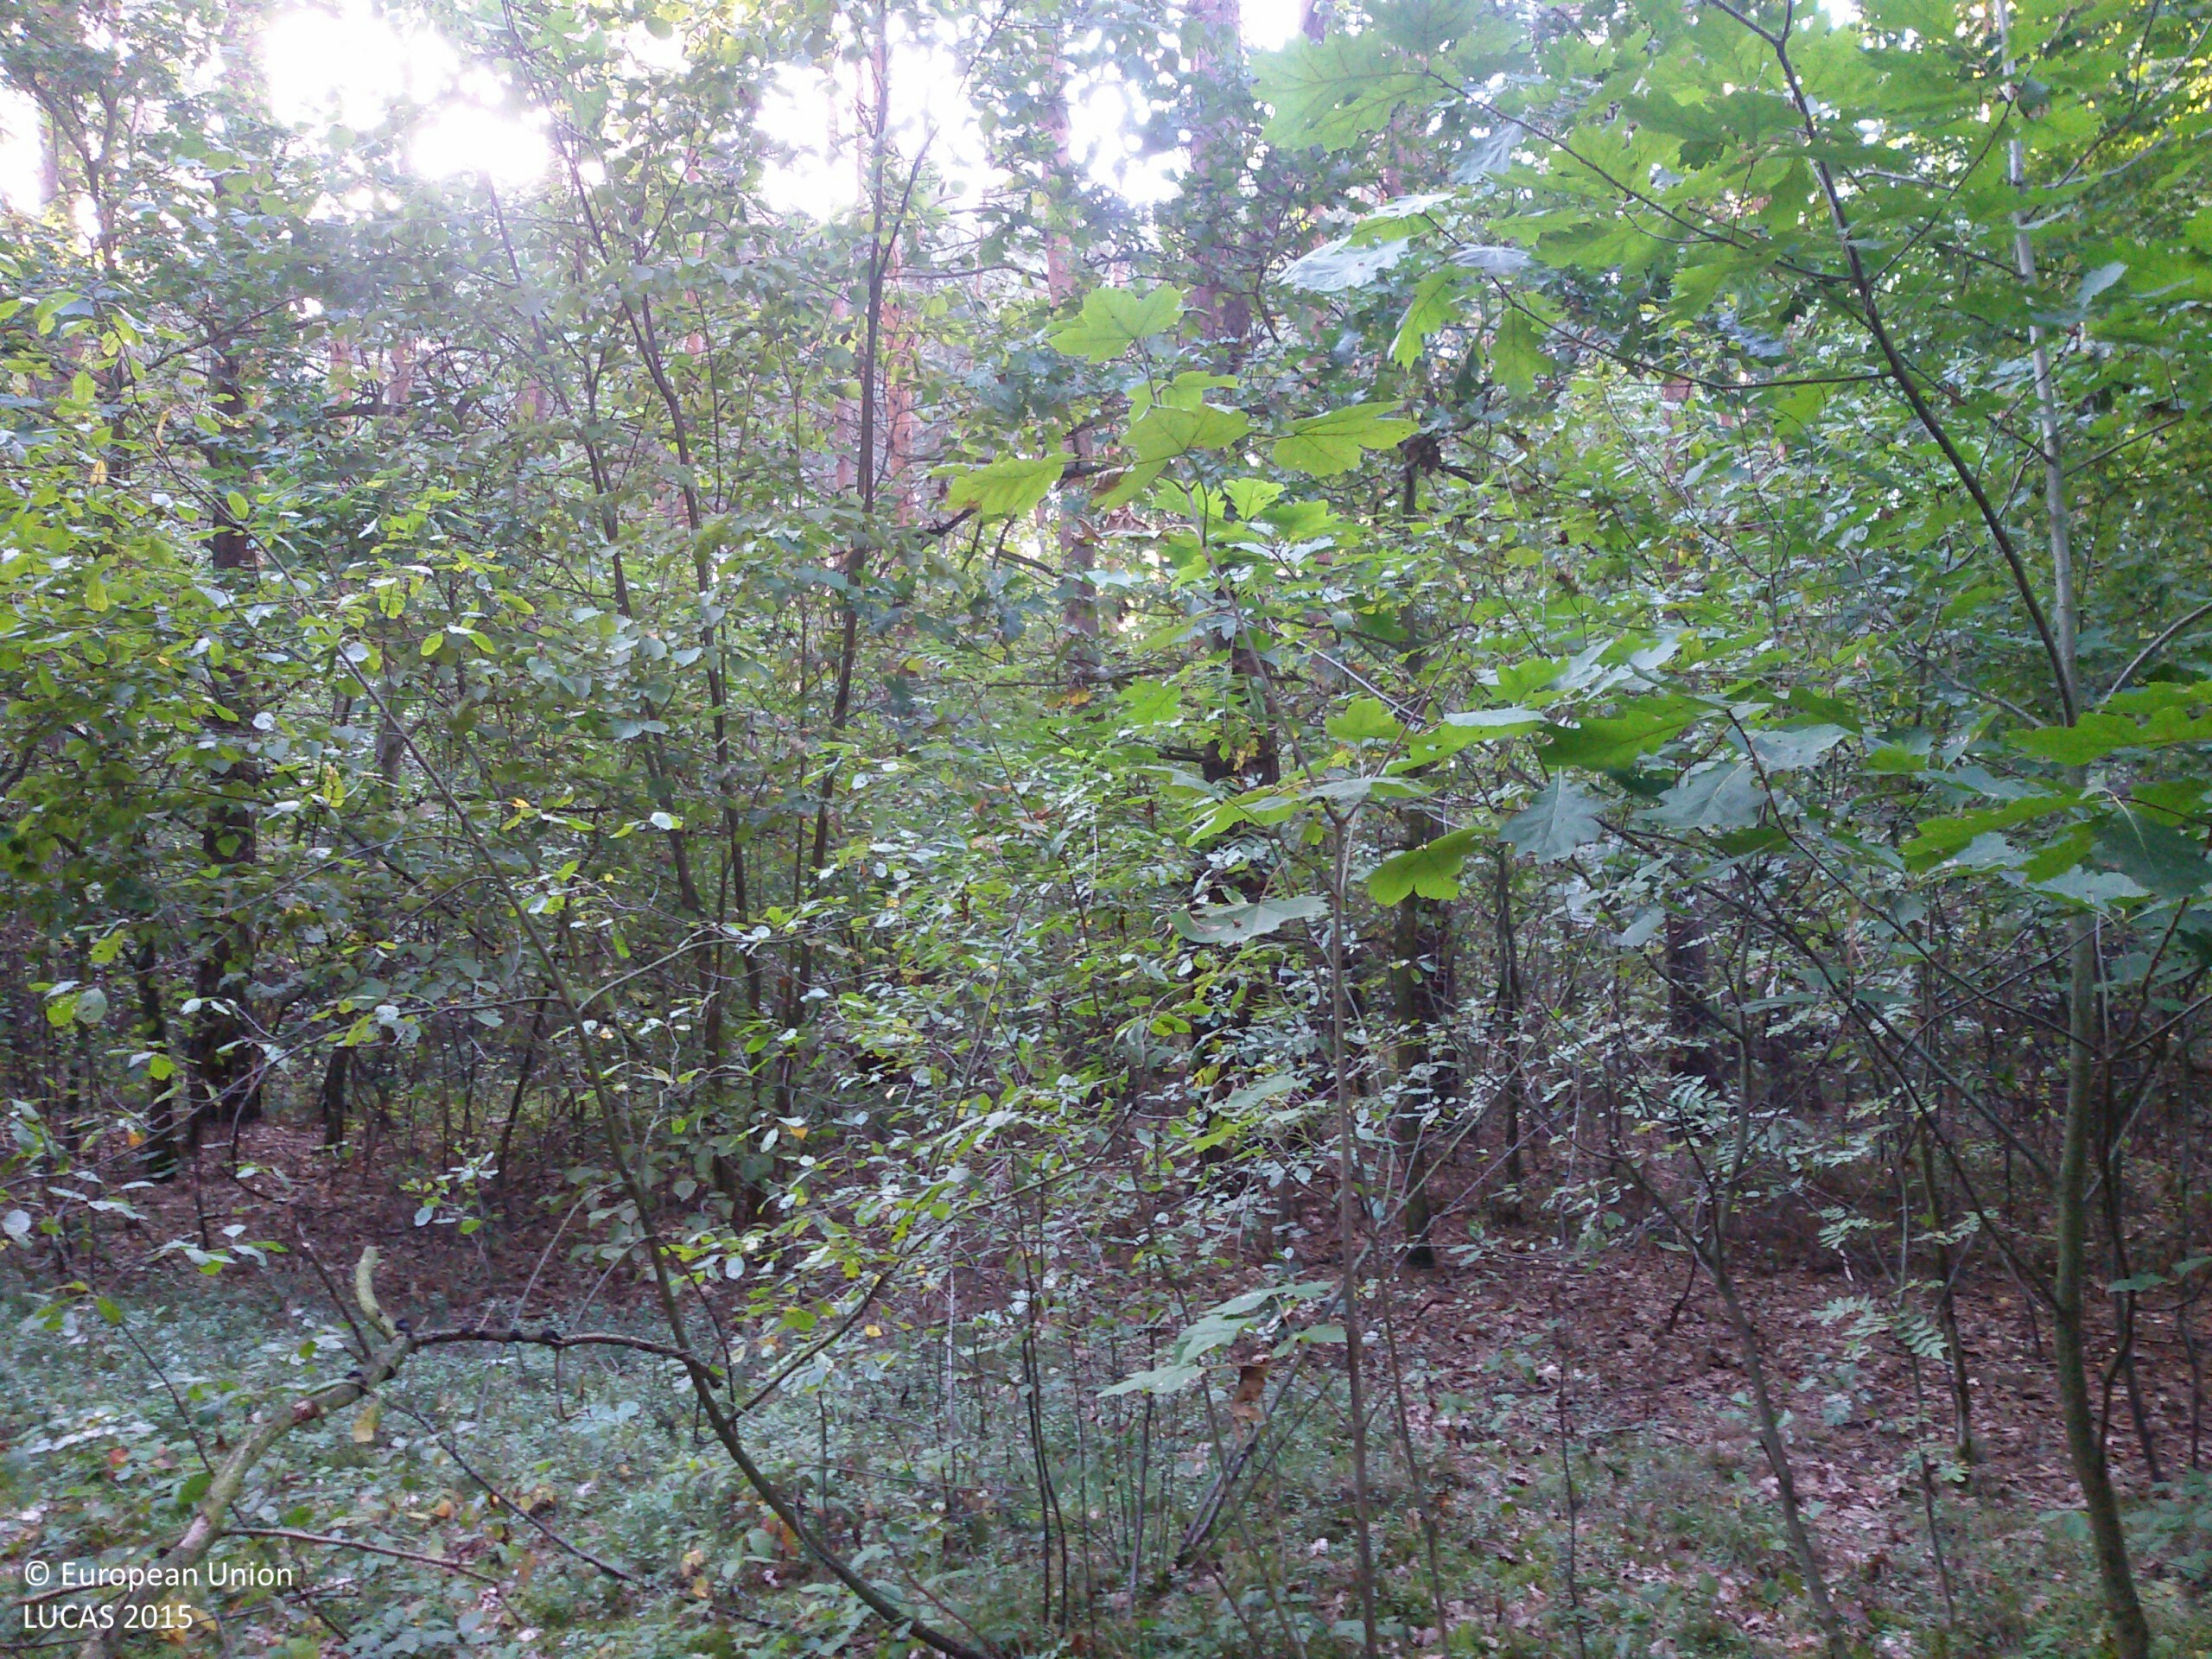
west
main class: Woodland
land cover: Pine dominated mixed woodland
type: hemiboreal forest and nemoral coniferous forest and mixed broadleaved-coniferous forest
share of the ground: > 75 %
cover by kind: coniferous forest trees 55 %, broadleaved forest trees 30 %, shrubs 10 %, herbaceous plants 5 %
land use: Forestry
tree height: > 5 m
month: September
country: PL
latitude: 50.9167
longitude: 19.6304
